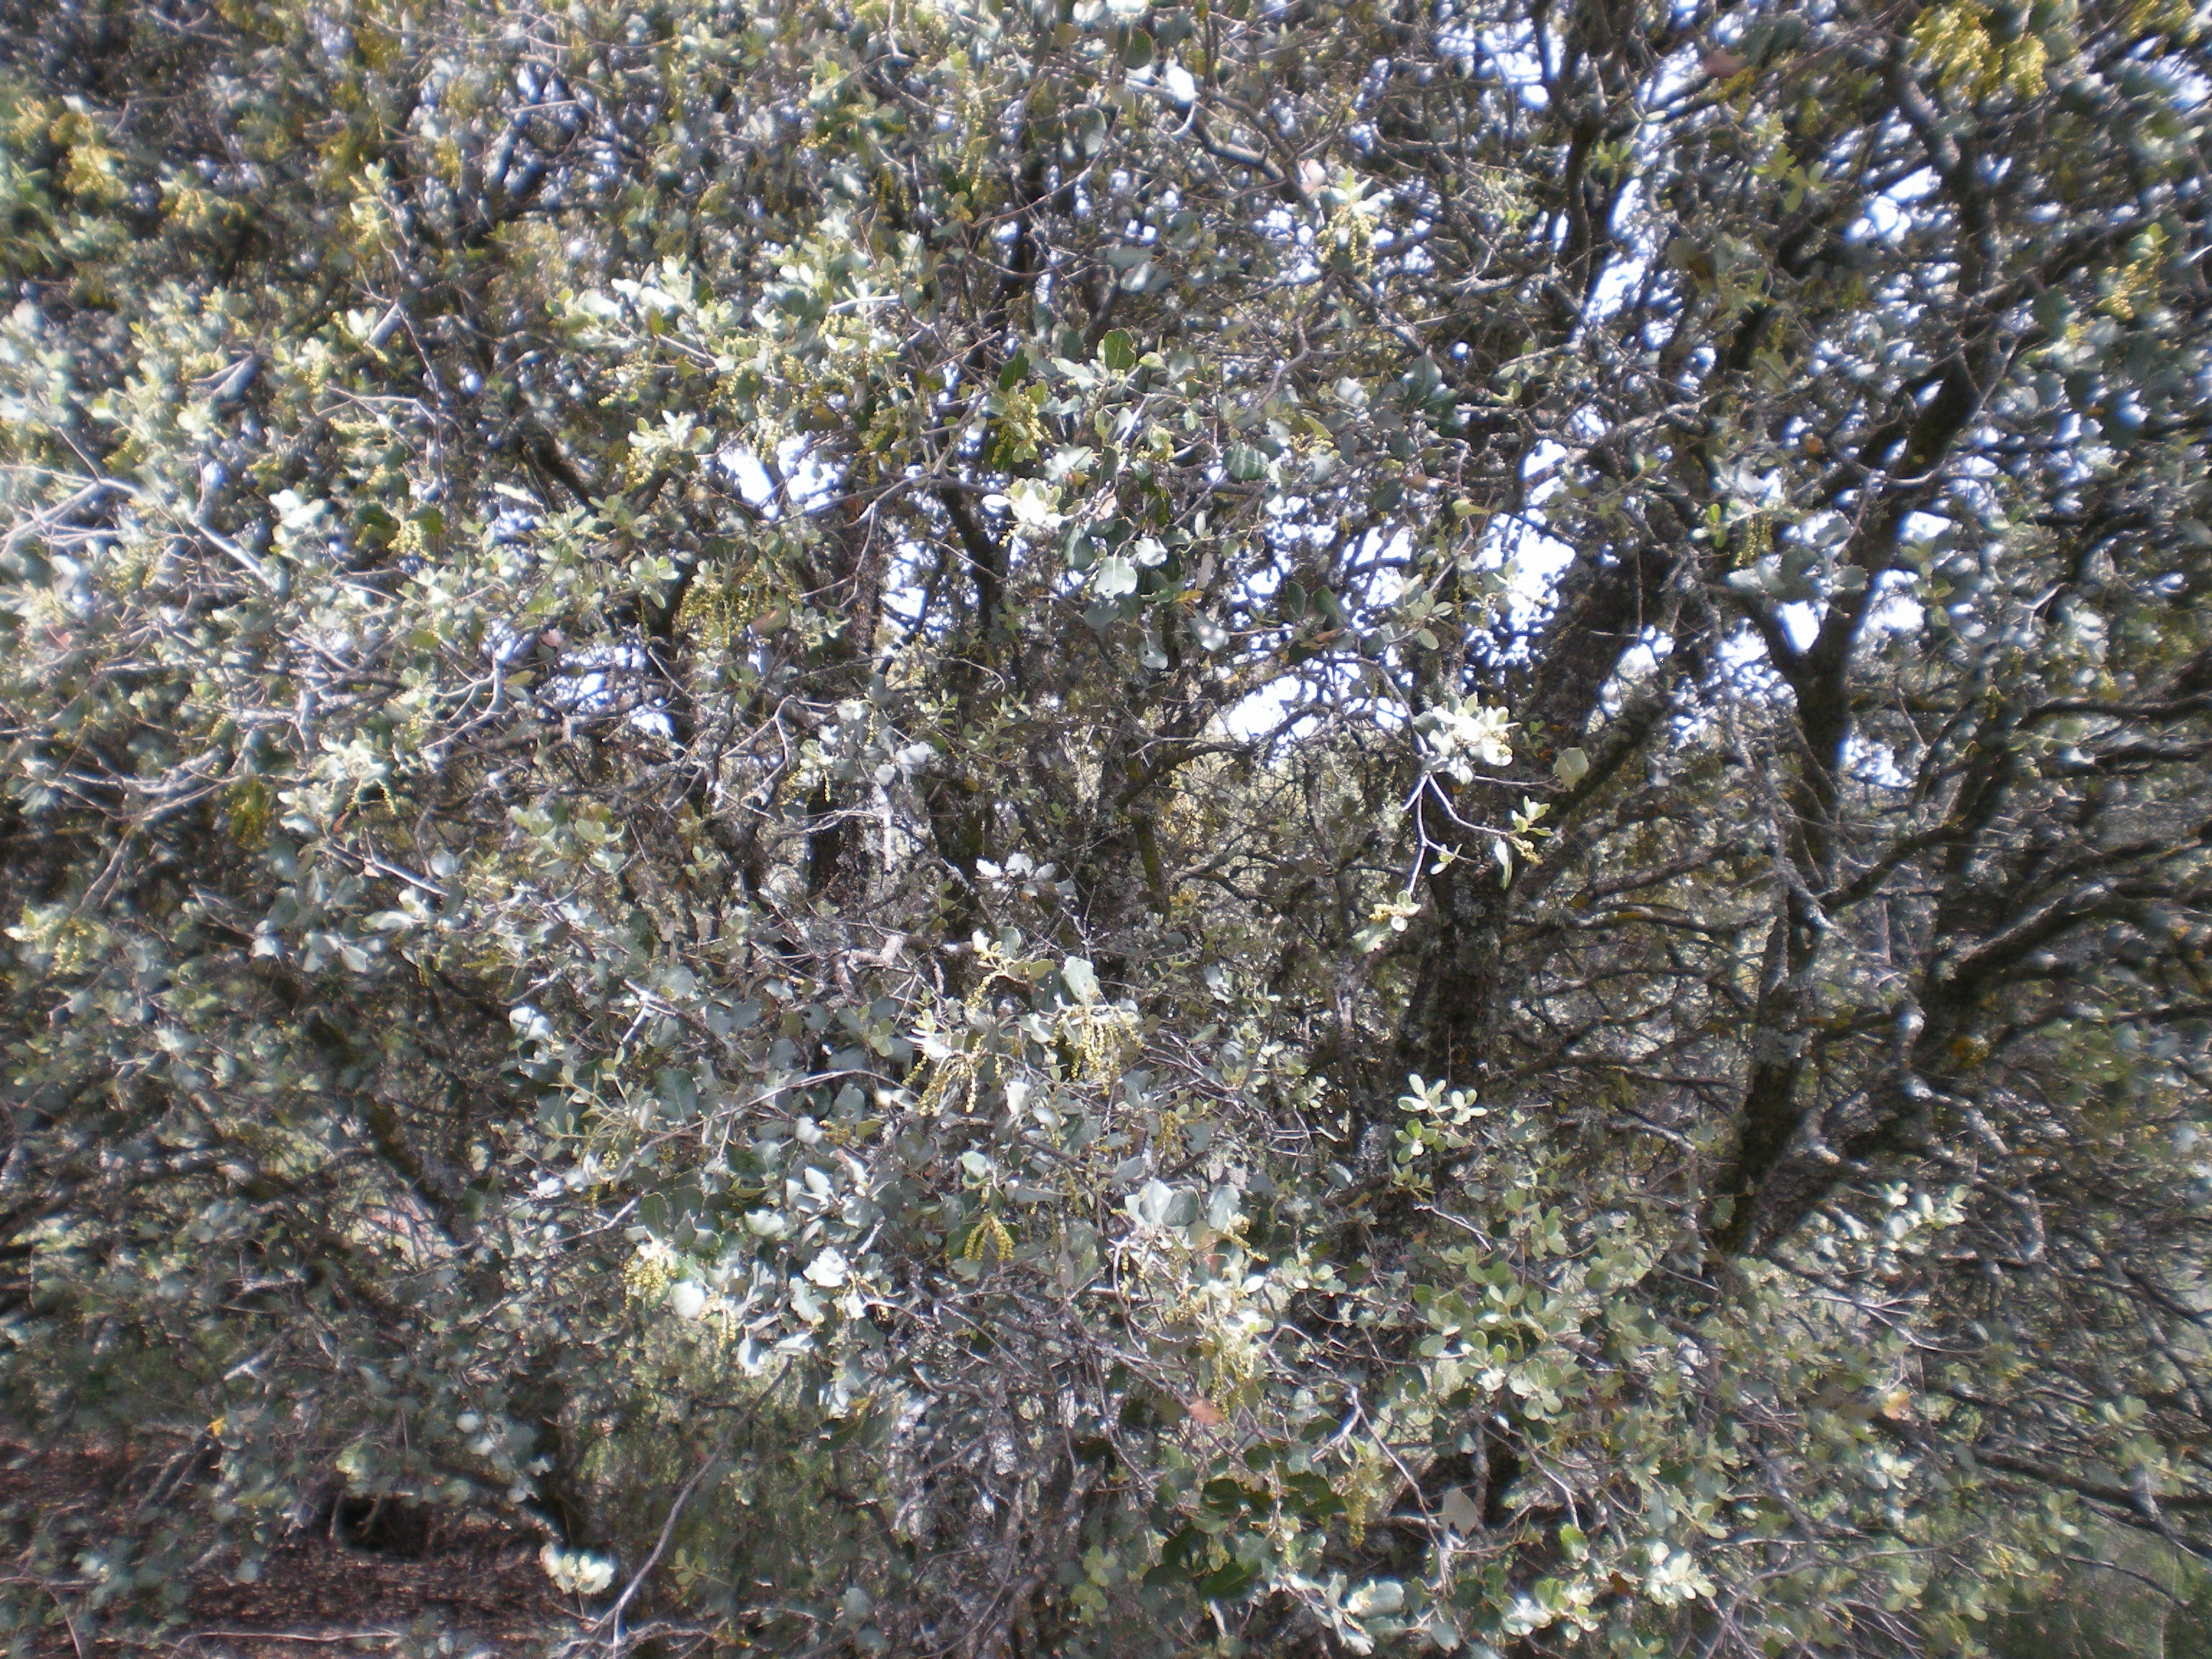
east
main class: Woodland
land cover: Broadleaved woodland
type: broadleaved evergreen forest
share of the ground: 50 - 75 %
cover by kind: broadleaved forest trees 30 %, shrubs 30 %, herbaceous plants 20 %, unconsolidated bare surface 20 %
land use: Other primary production
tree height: < 5 m
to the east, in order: Broadleaved woodland; Tracks; Broadleaved woodland
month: May
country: ES
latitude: 38.9065
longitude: -2.9818
